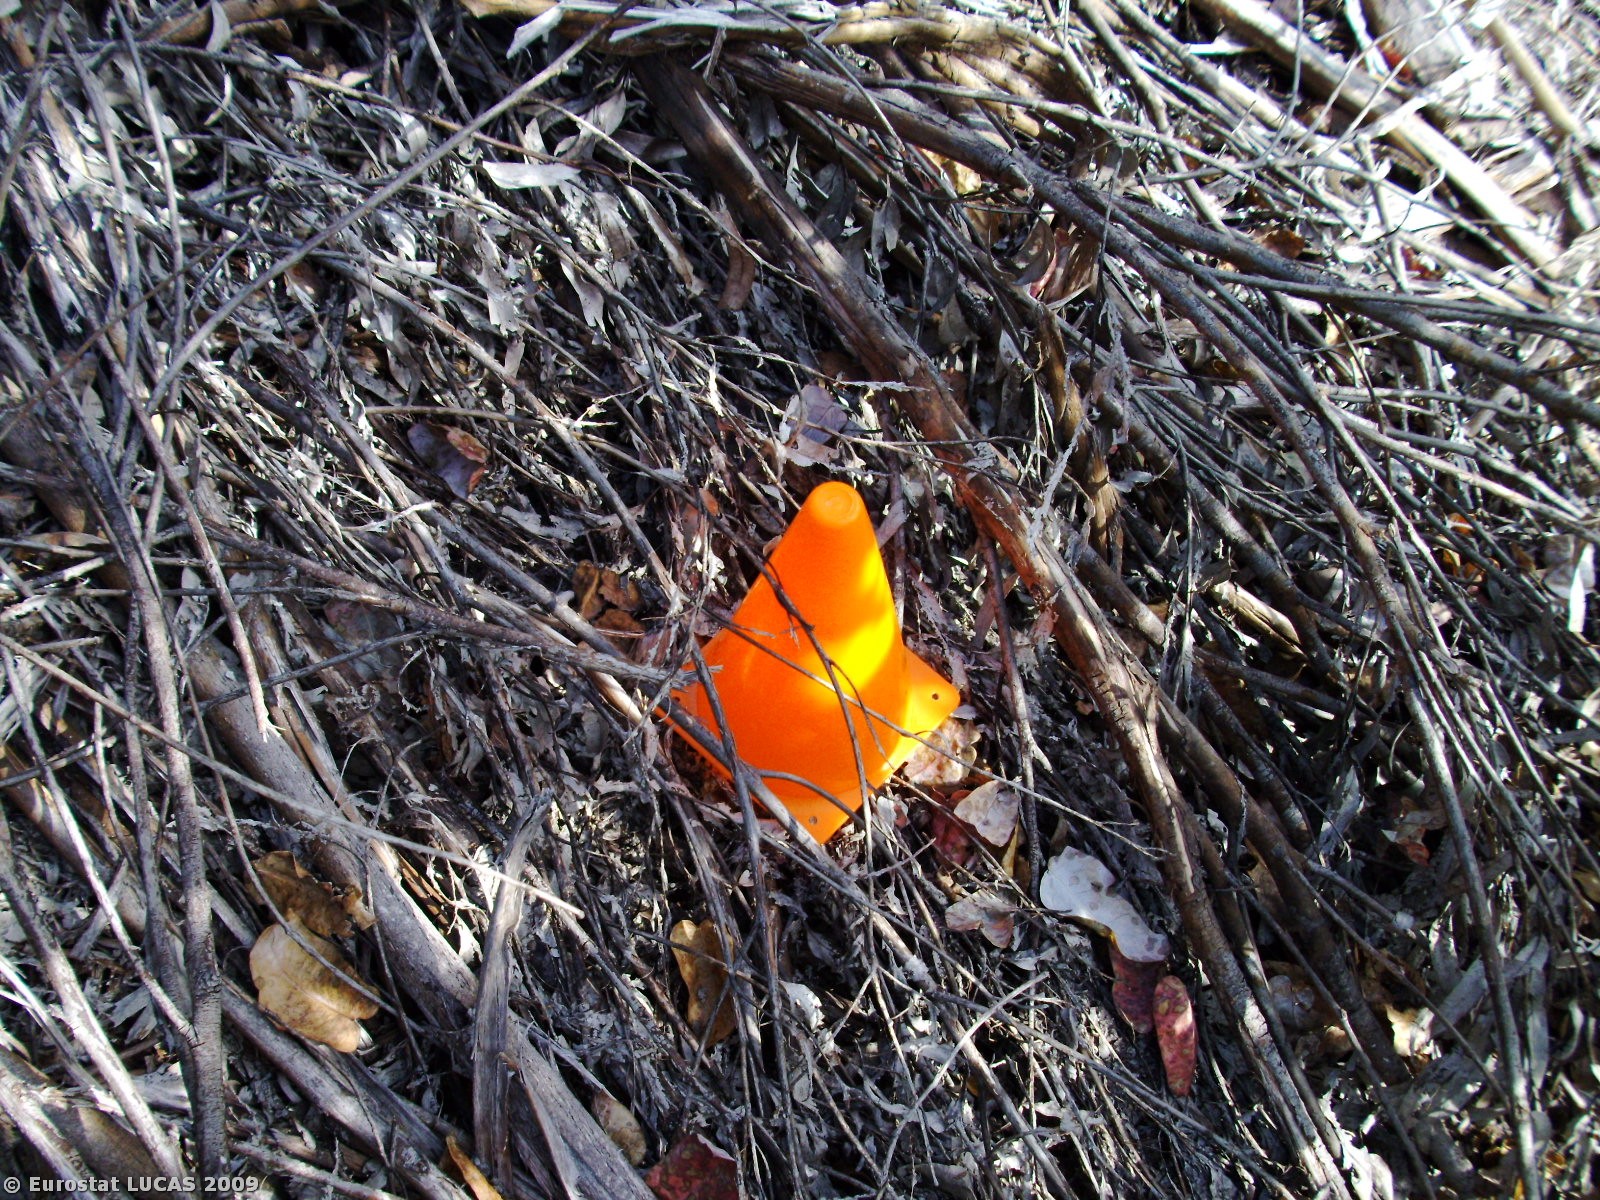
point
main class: Woodland
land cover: Broadleaved woodland
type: plantations and self-sown exotic forest
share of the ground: > 75 %
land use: Forestry
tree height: > 5 m
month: May
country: PT
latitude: 40.4609
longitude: -8.3531
